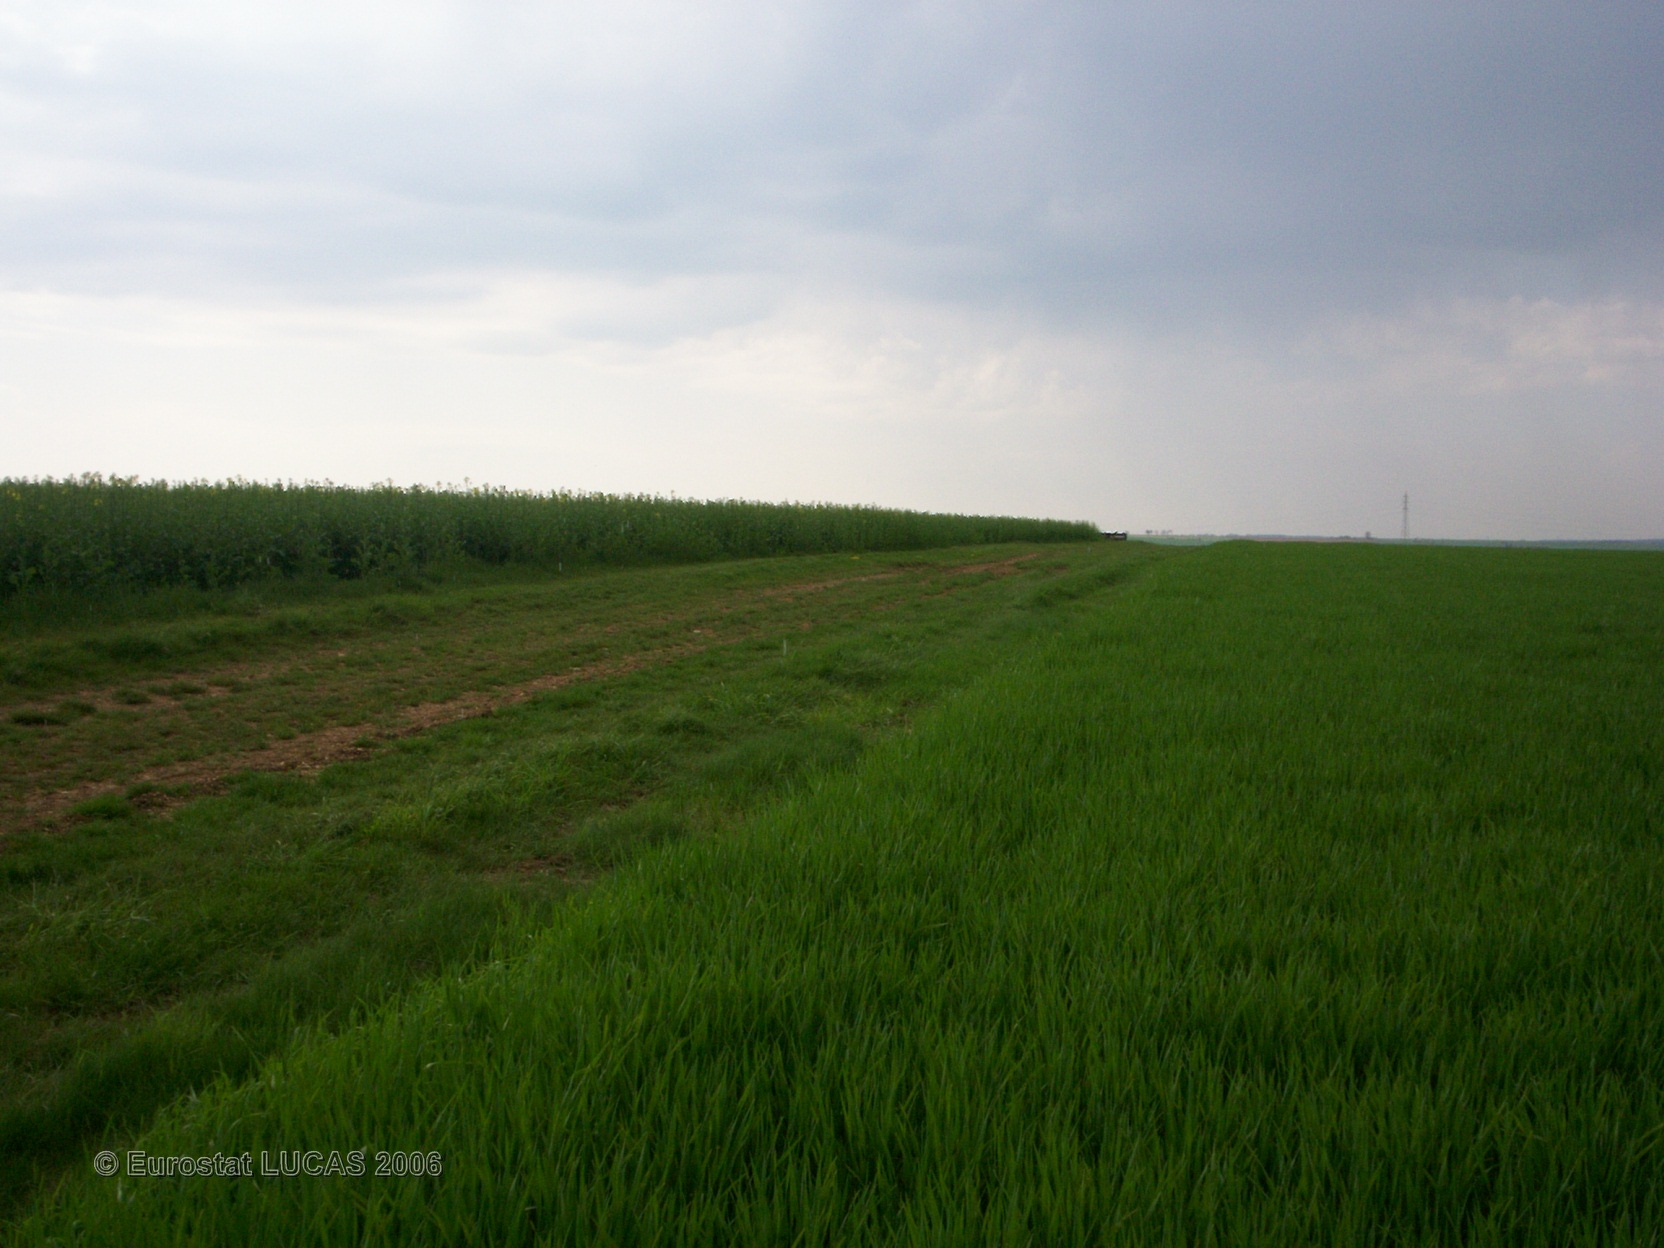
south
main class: Cropland
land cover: Barley
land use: Agriculture (excluding fallow land and kitchen gardens)
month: April
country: FR
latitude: 47.3910
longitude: 3.0662
